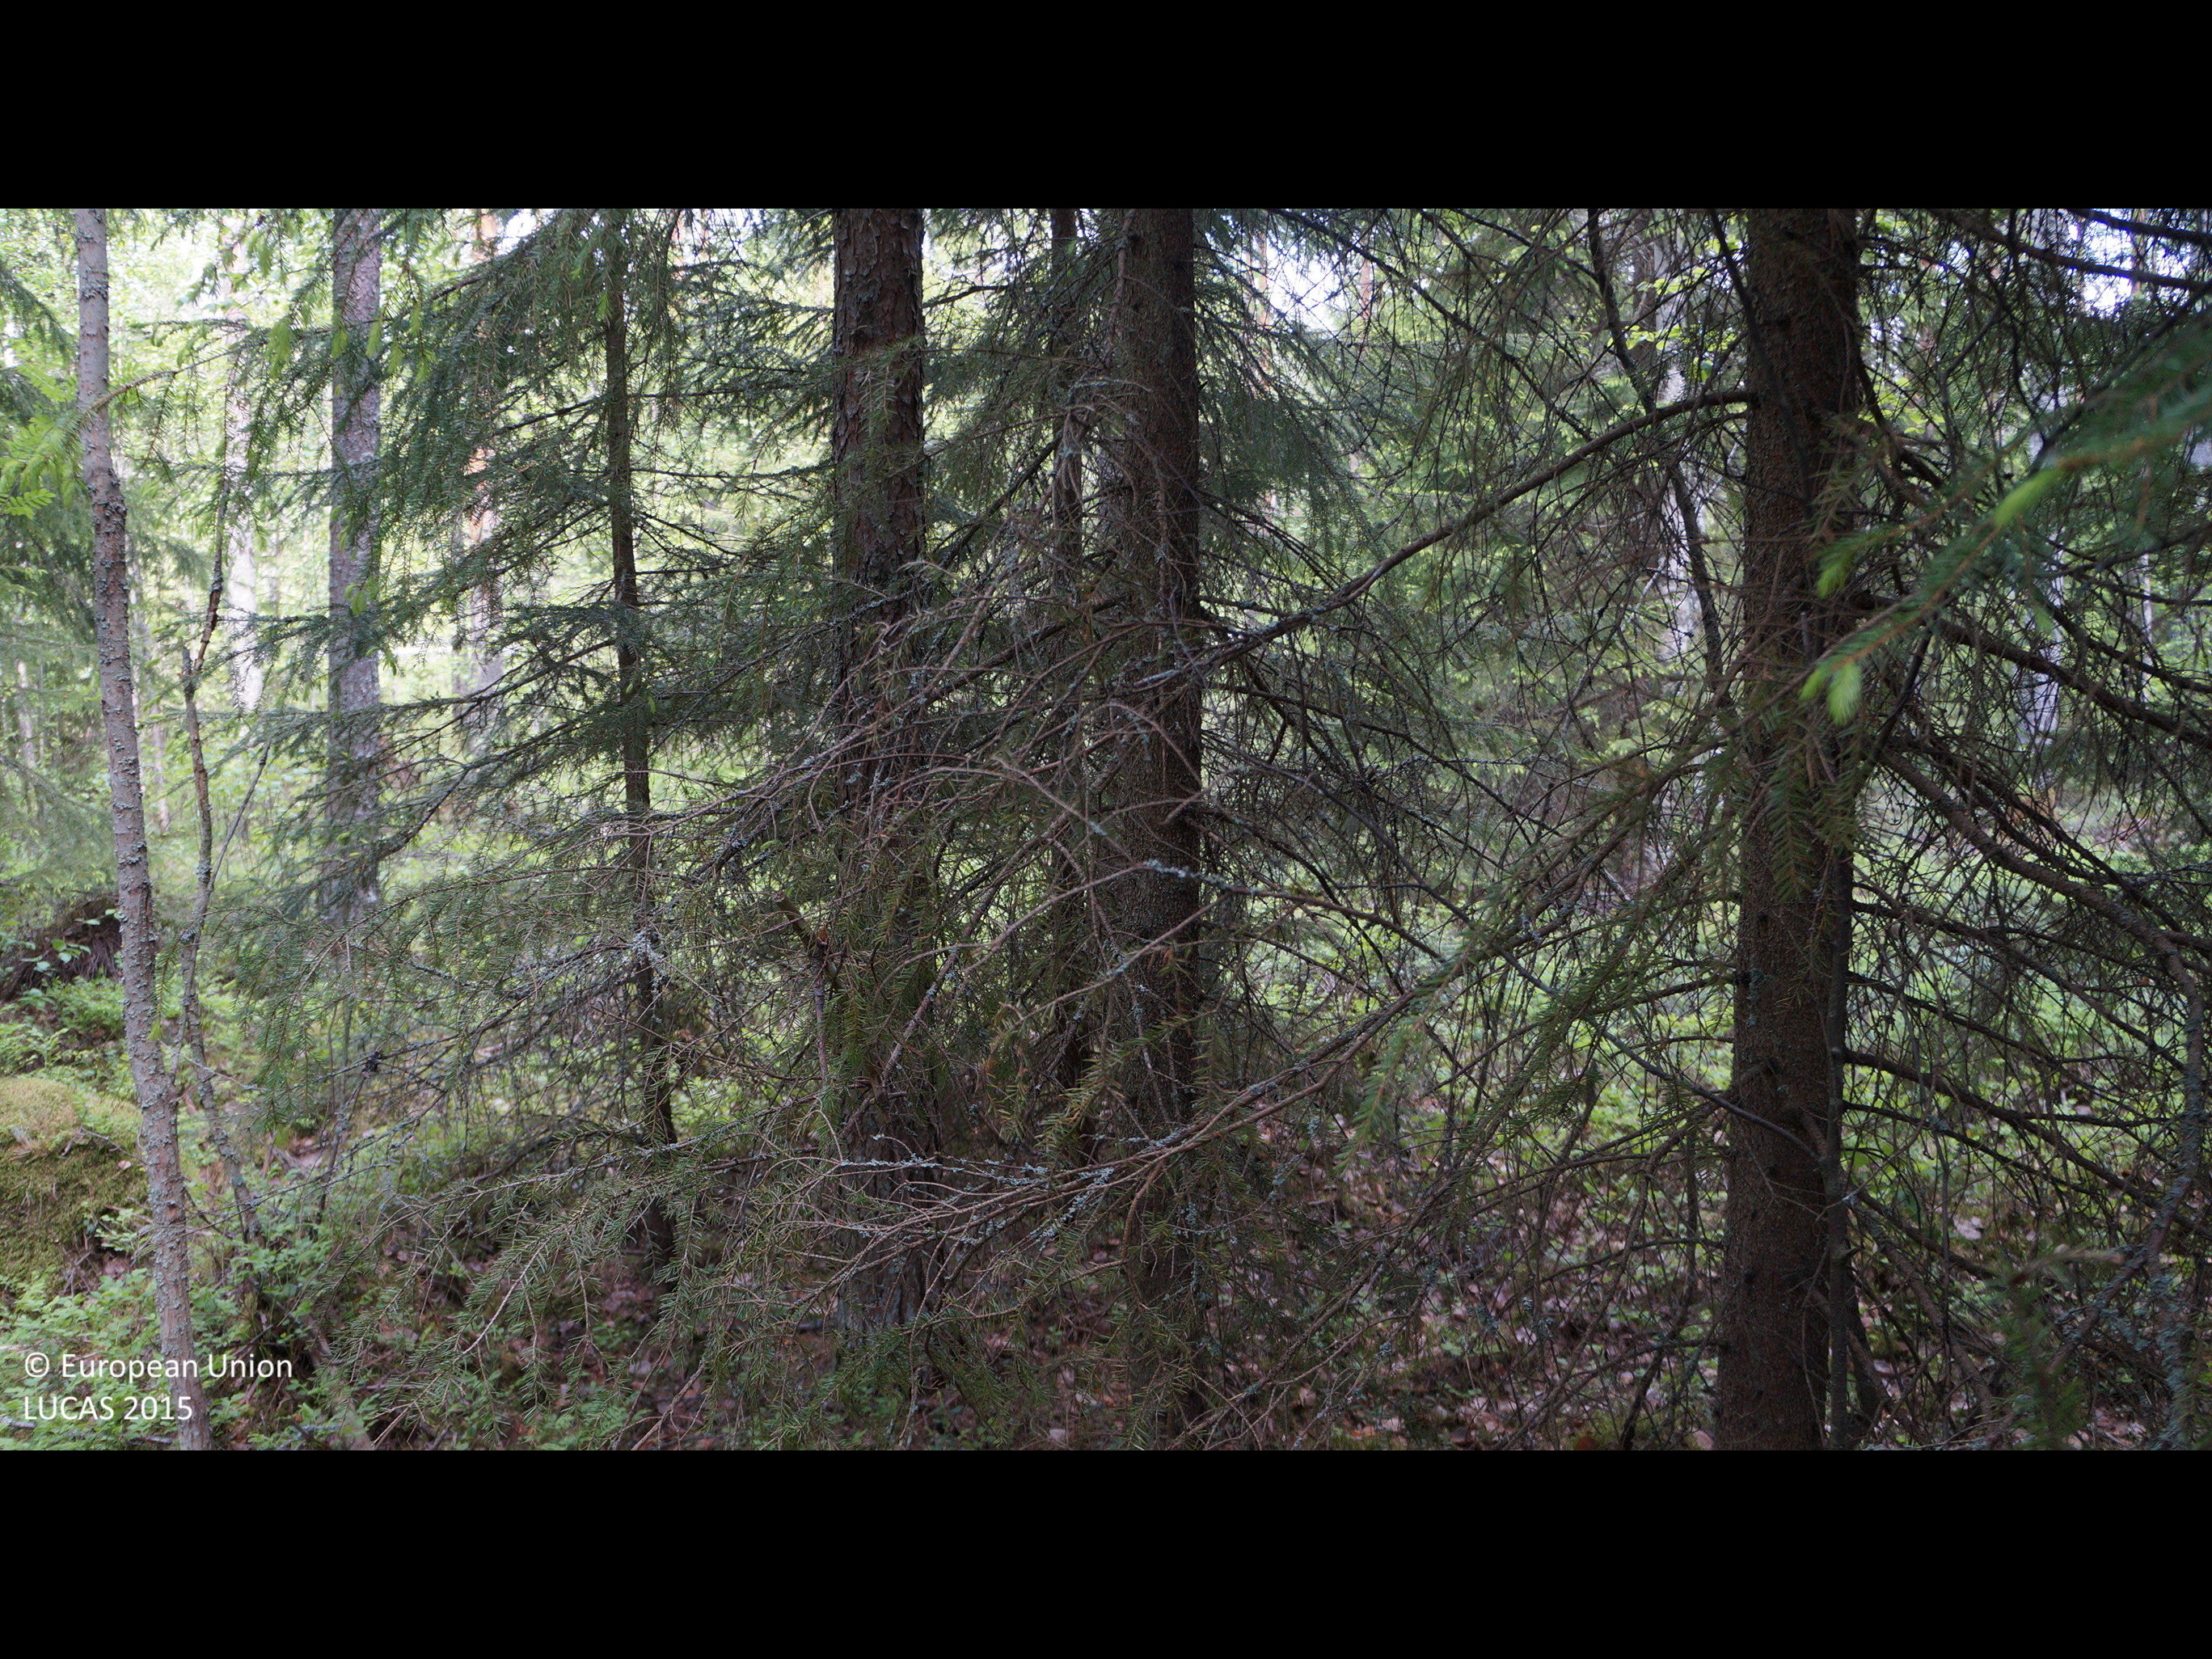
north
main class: Woodland
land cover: Other coniferous woodland
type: boreal forest
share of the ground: > 75 %
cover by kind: coniferous forest trees 70 %, shrubs 15 %, lichens and mosses 10 %, broadleaved forest trees 5 %
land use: Forestry
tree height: > 5 m
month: June
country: FI
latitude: 64.1194
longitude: 25.2213
